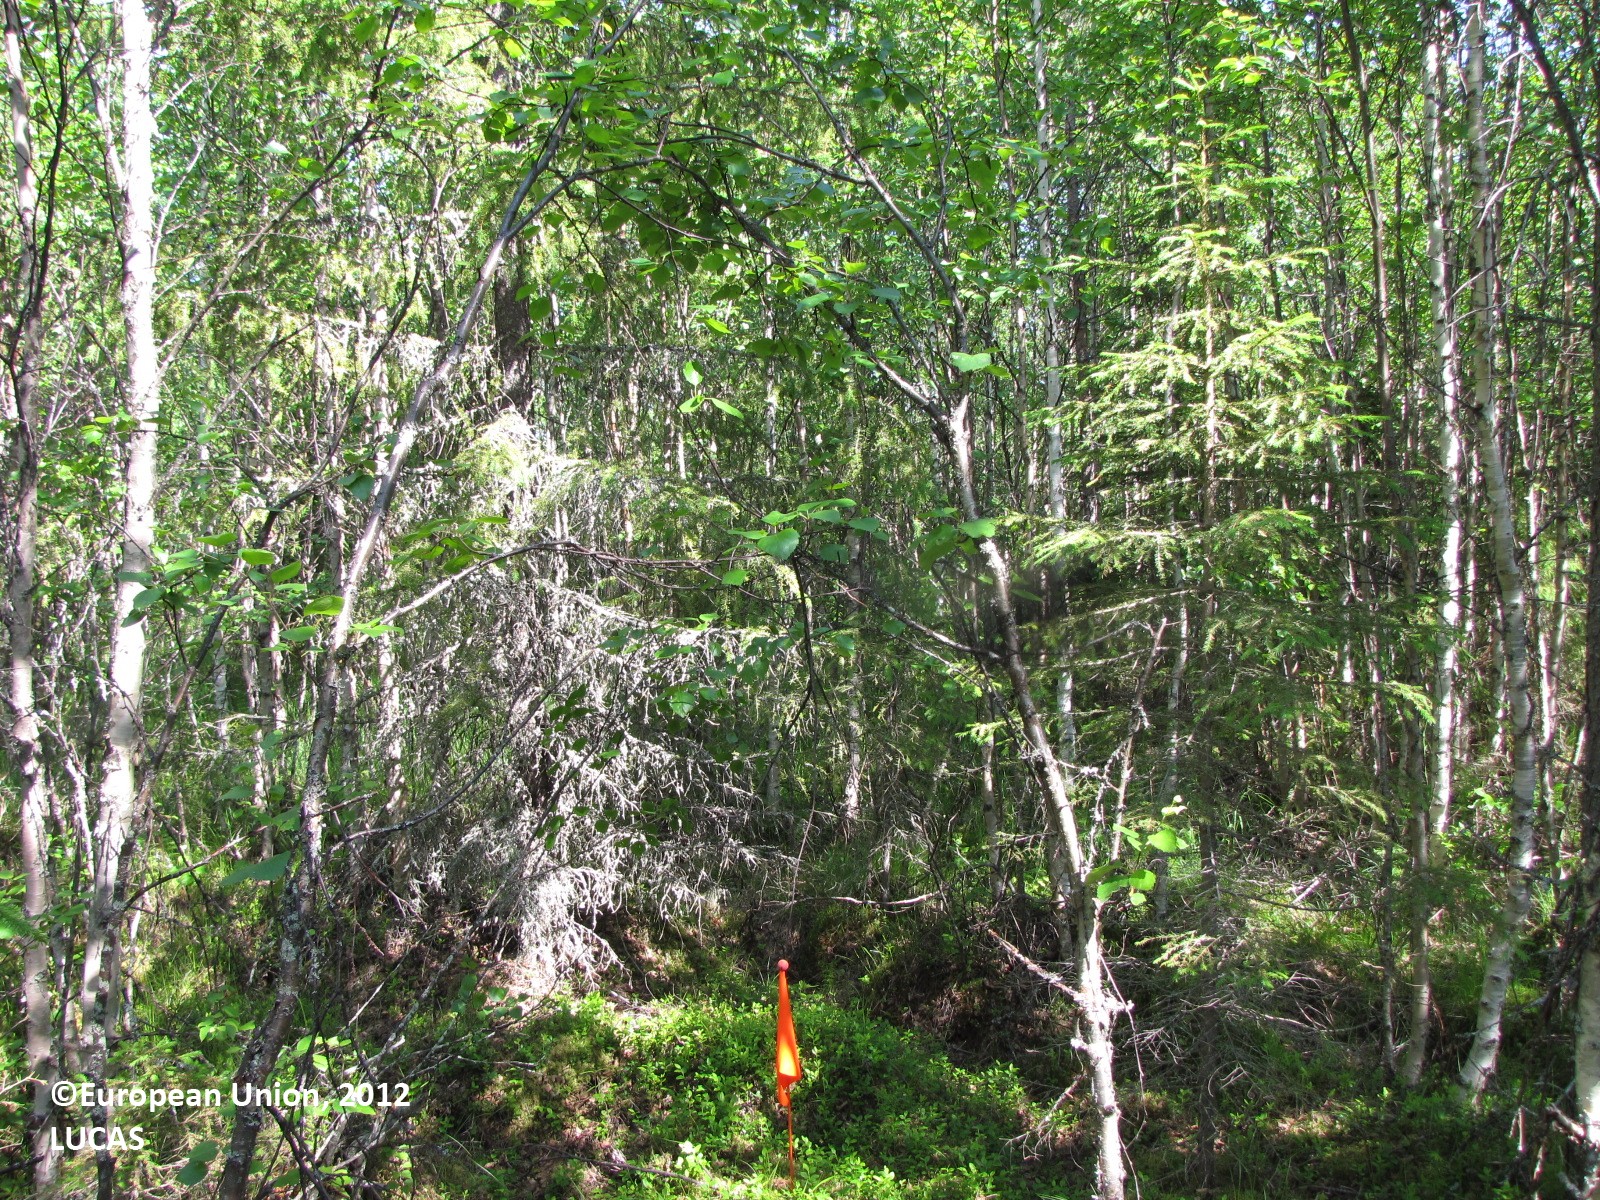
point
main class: Woodland
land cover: Other mixed woodland
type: boreal forest
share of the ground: > 75 %
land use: Forestry
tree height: > 5 m
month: July
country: FI
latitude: 66.2922
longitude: 25.3309
